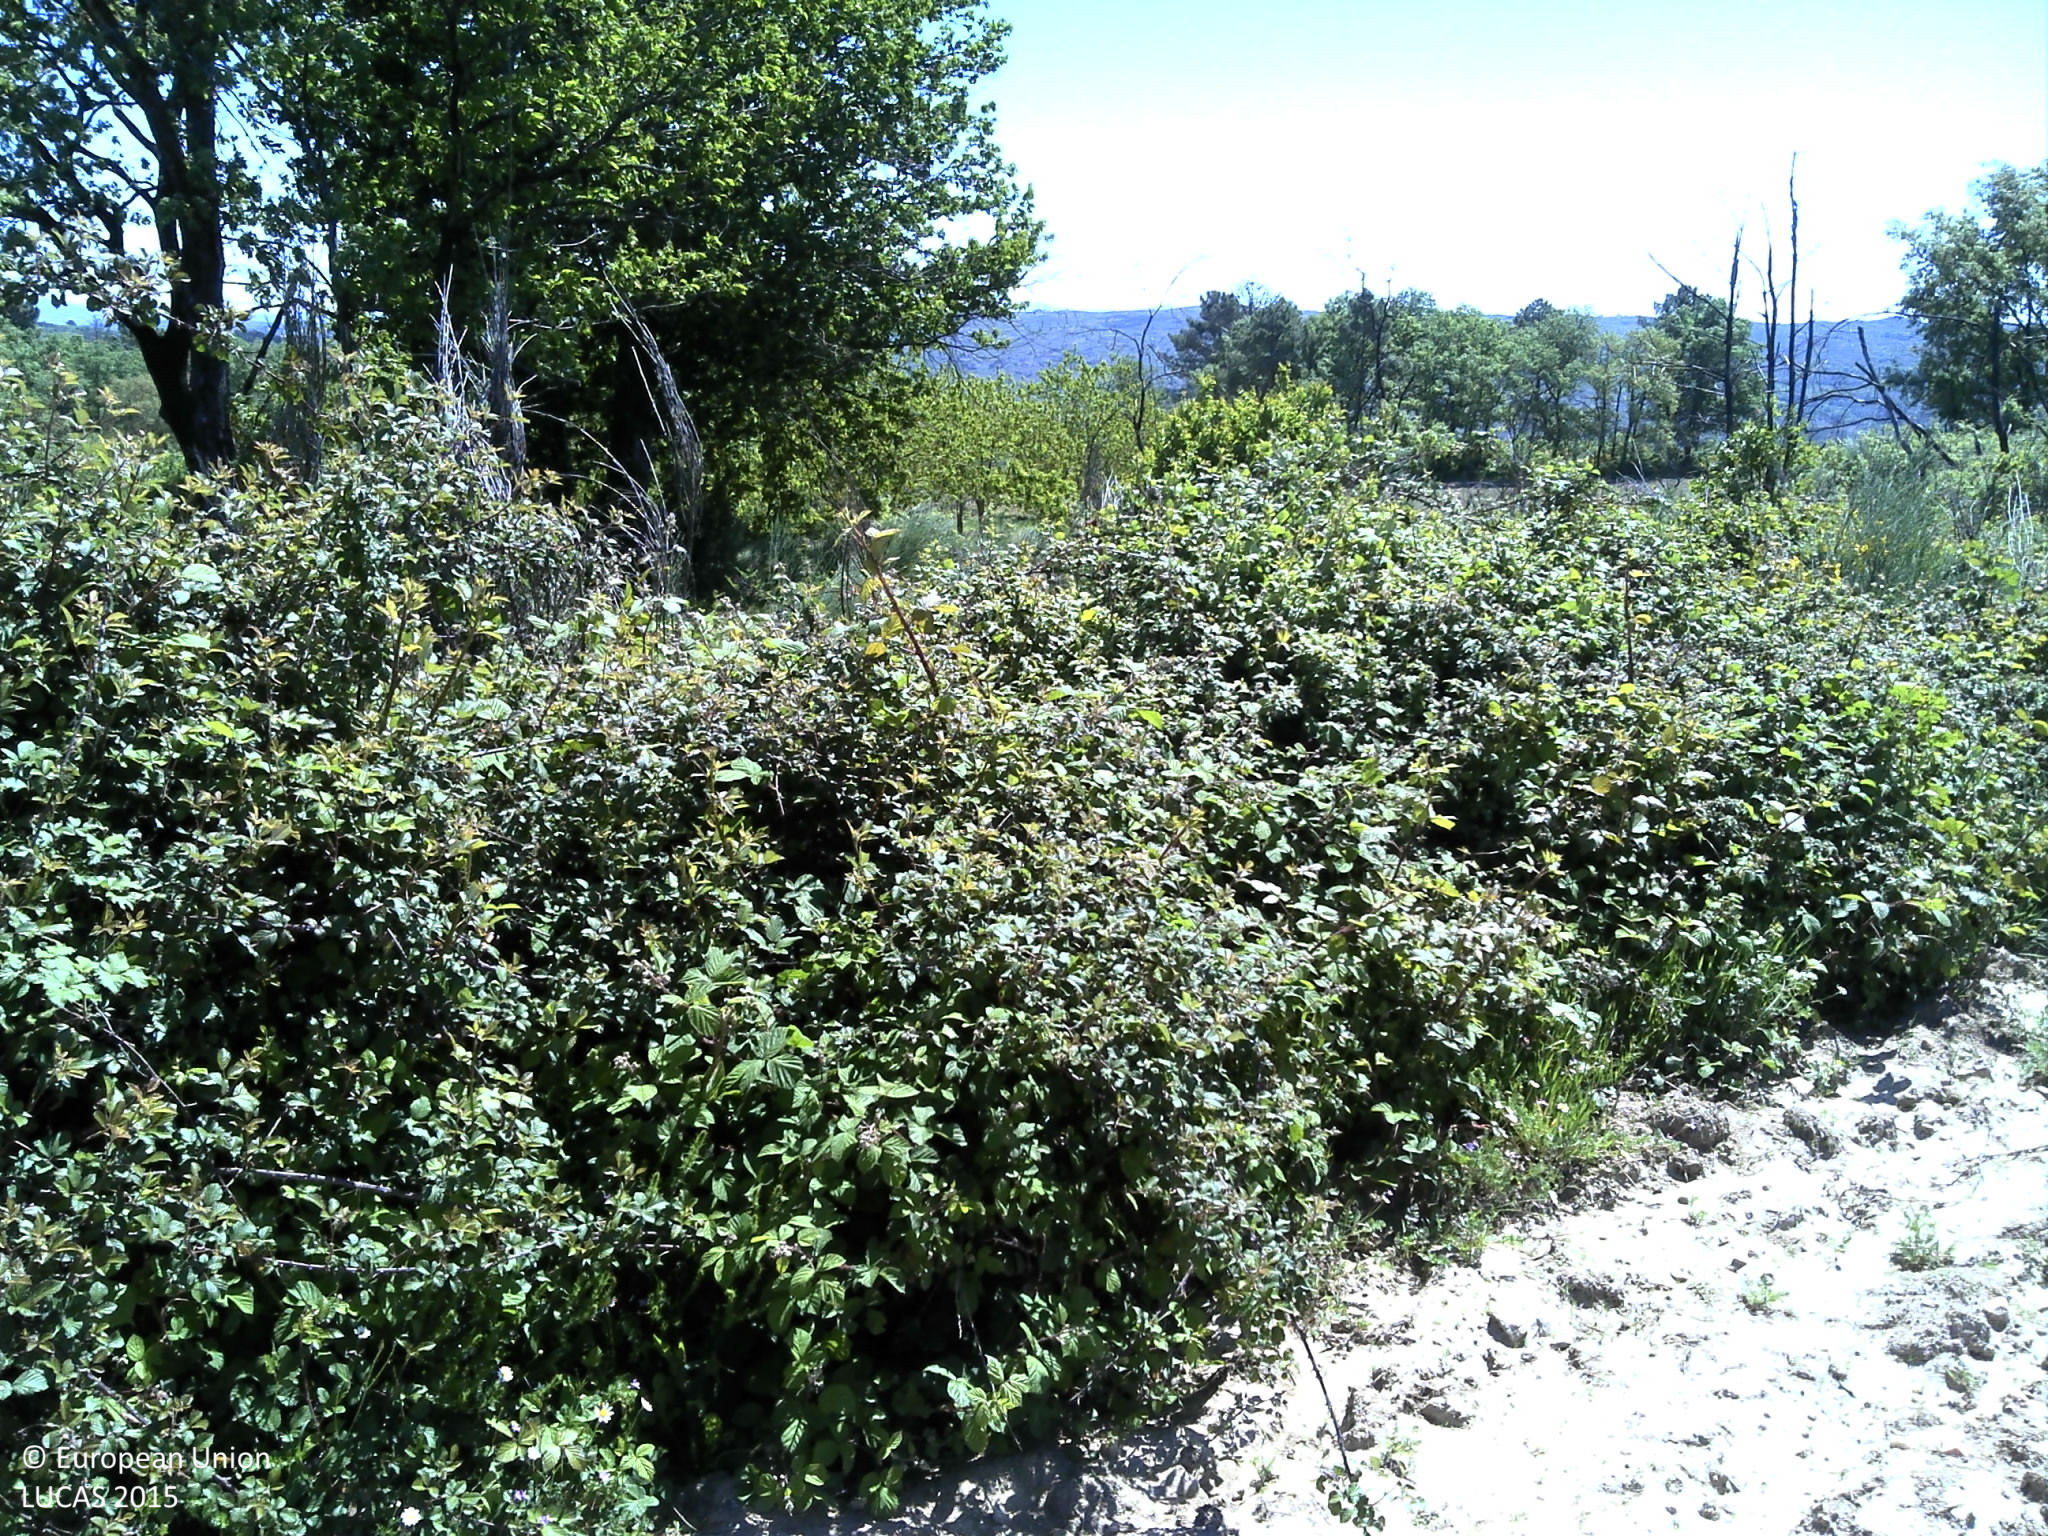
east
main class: Cropland
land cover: Nuts trees
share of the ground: < 10 %
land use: Agriculture (excluding fallow land and kitchen gardens)
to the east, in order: Nuts trees; Shrubland without tree cover; Tracks; Shrubland with sparse tree cover; Dry stone walls; Nuts trees; Dry stone walls; Lines of trees; Spontaneously vegetated surfaces; Dry stone walls; Shrubland with sparse tree cover; Tracks; Shrubland with sparse tree cover
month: May
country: PT
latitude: 41.7361
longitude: -7.3317
